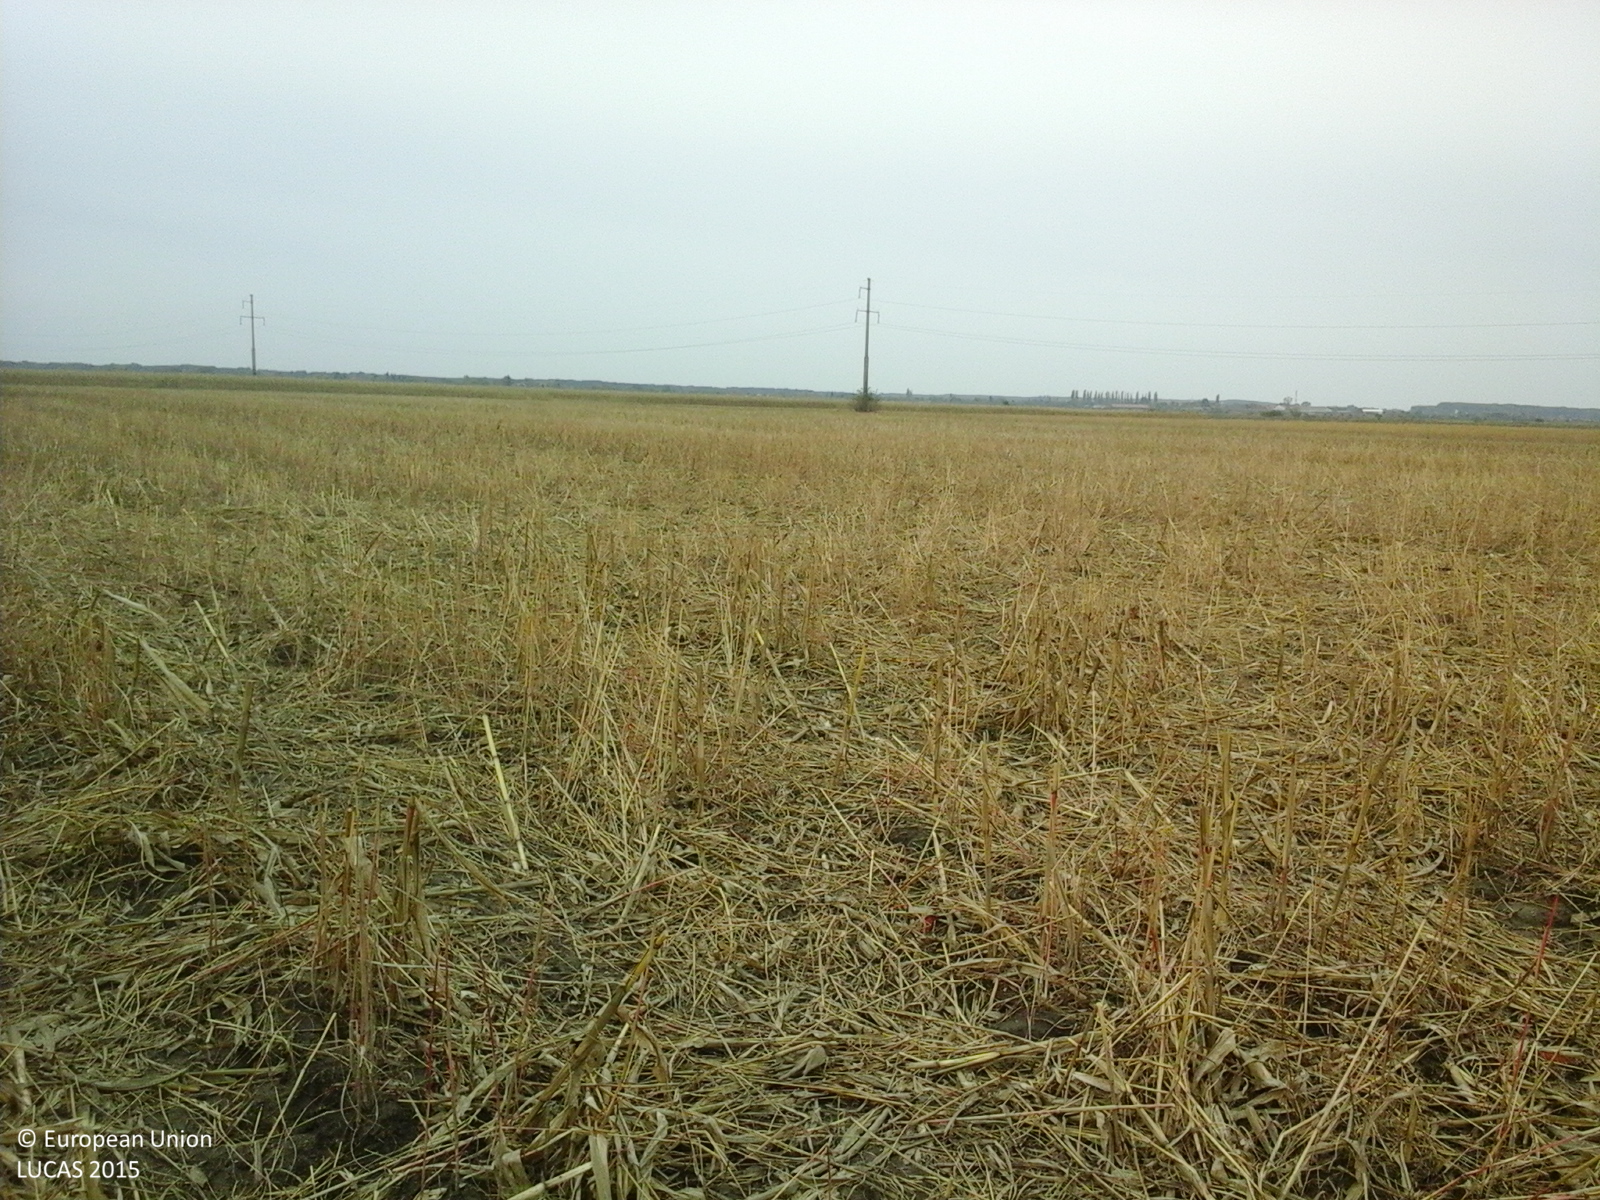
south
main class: Cropland
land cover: Maize
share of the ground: 10 - 25 %
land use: Agriculture (excluding fallow land and kitchen gardens)
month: October
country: RO
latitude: 44.8518
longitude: 26.2977
